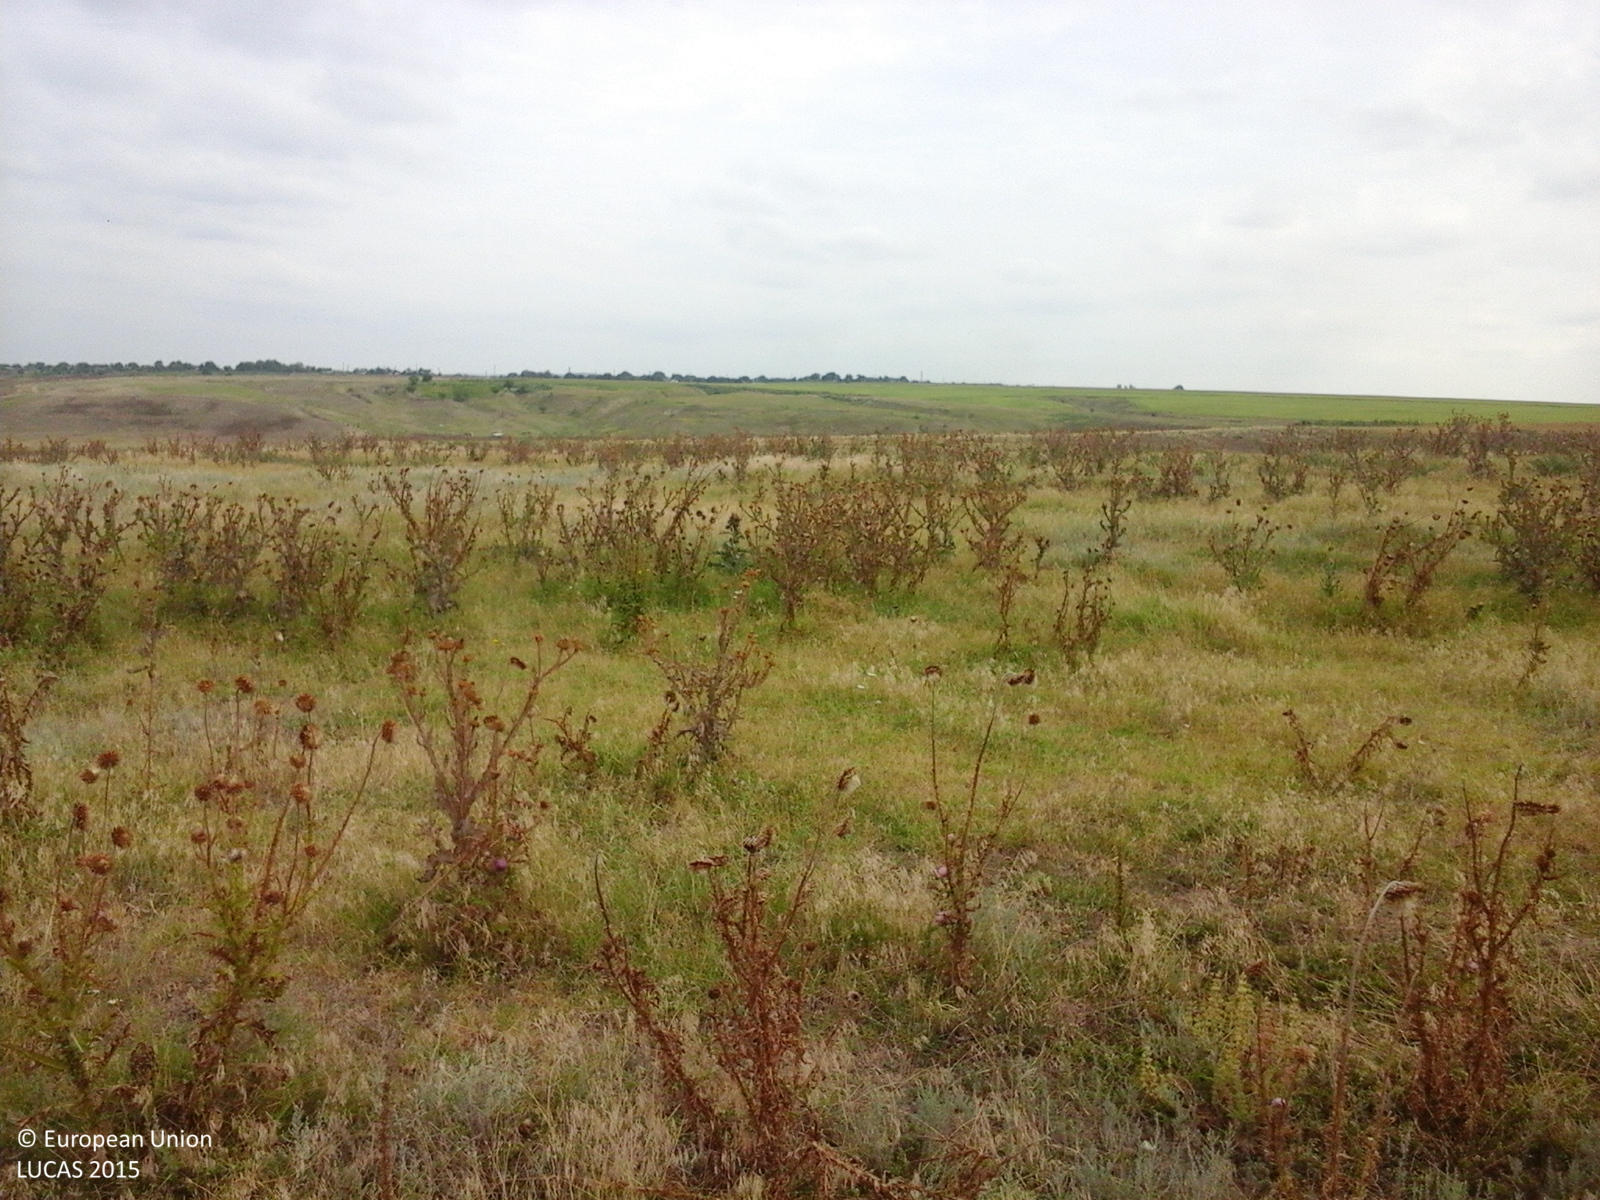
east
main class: Grassland
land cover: Spontaneously vegetated surfaces
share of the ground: > 75 %
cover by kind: herbaceous plants 100 %
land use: Fallow land
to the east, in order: Spontaneously vegetated surfaces; Tracks; Grassland without tree/shrub cover; Tracks; Grassland without tree/shrub cover; Common wheat
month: August
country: RO
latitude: 44.8250
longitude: 28.1118
